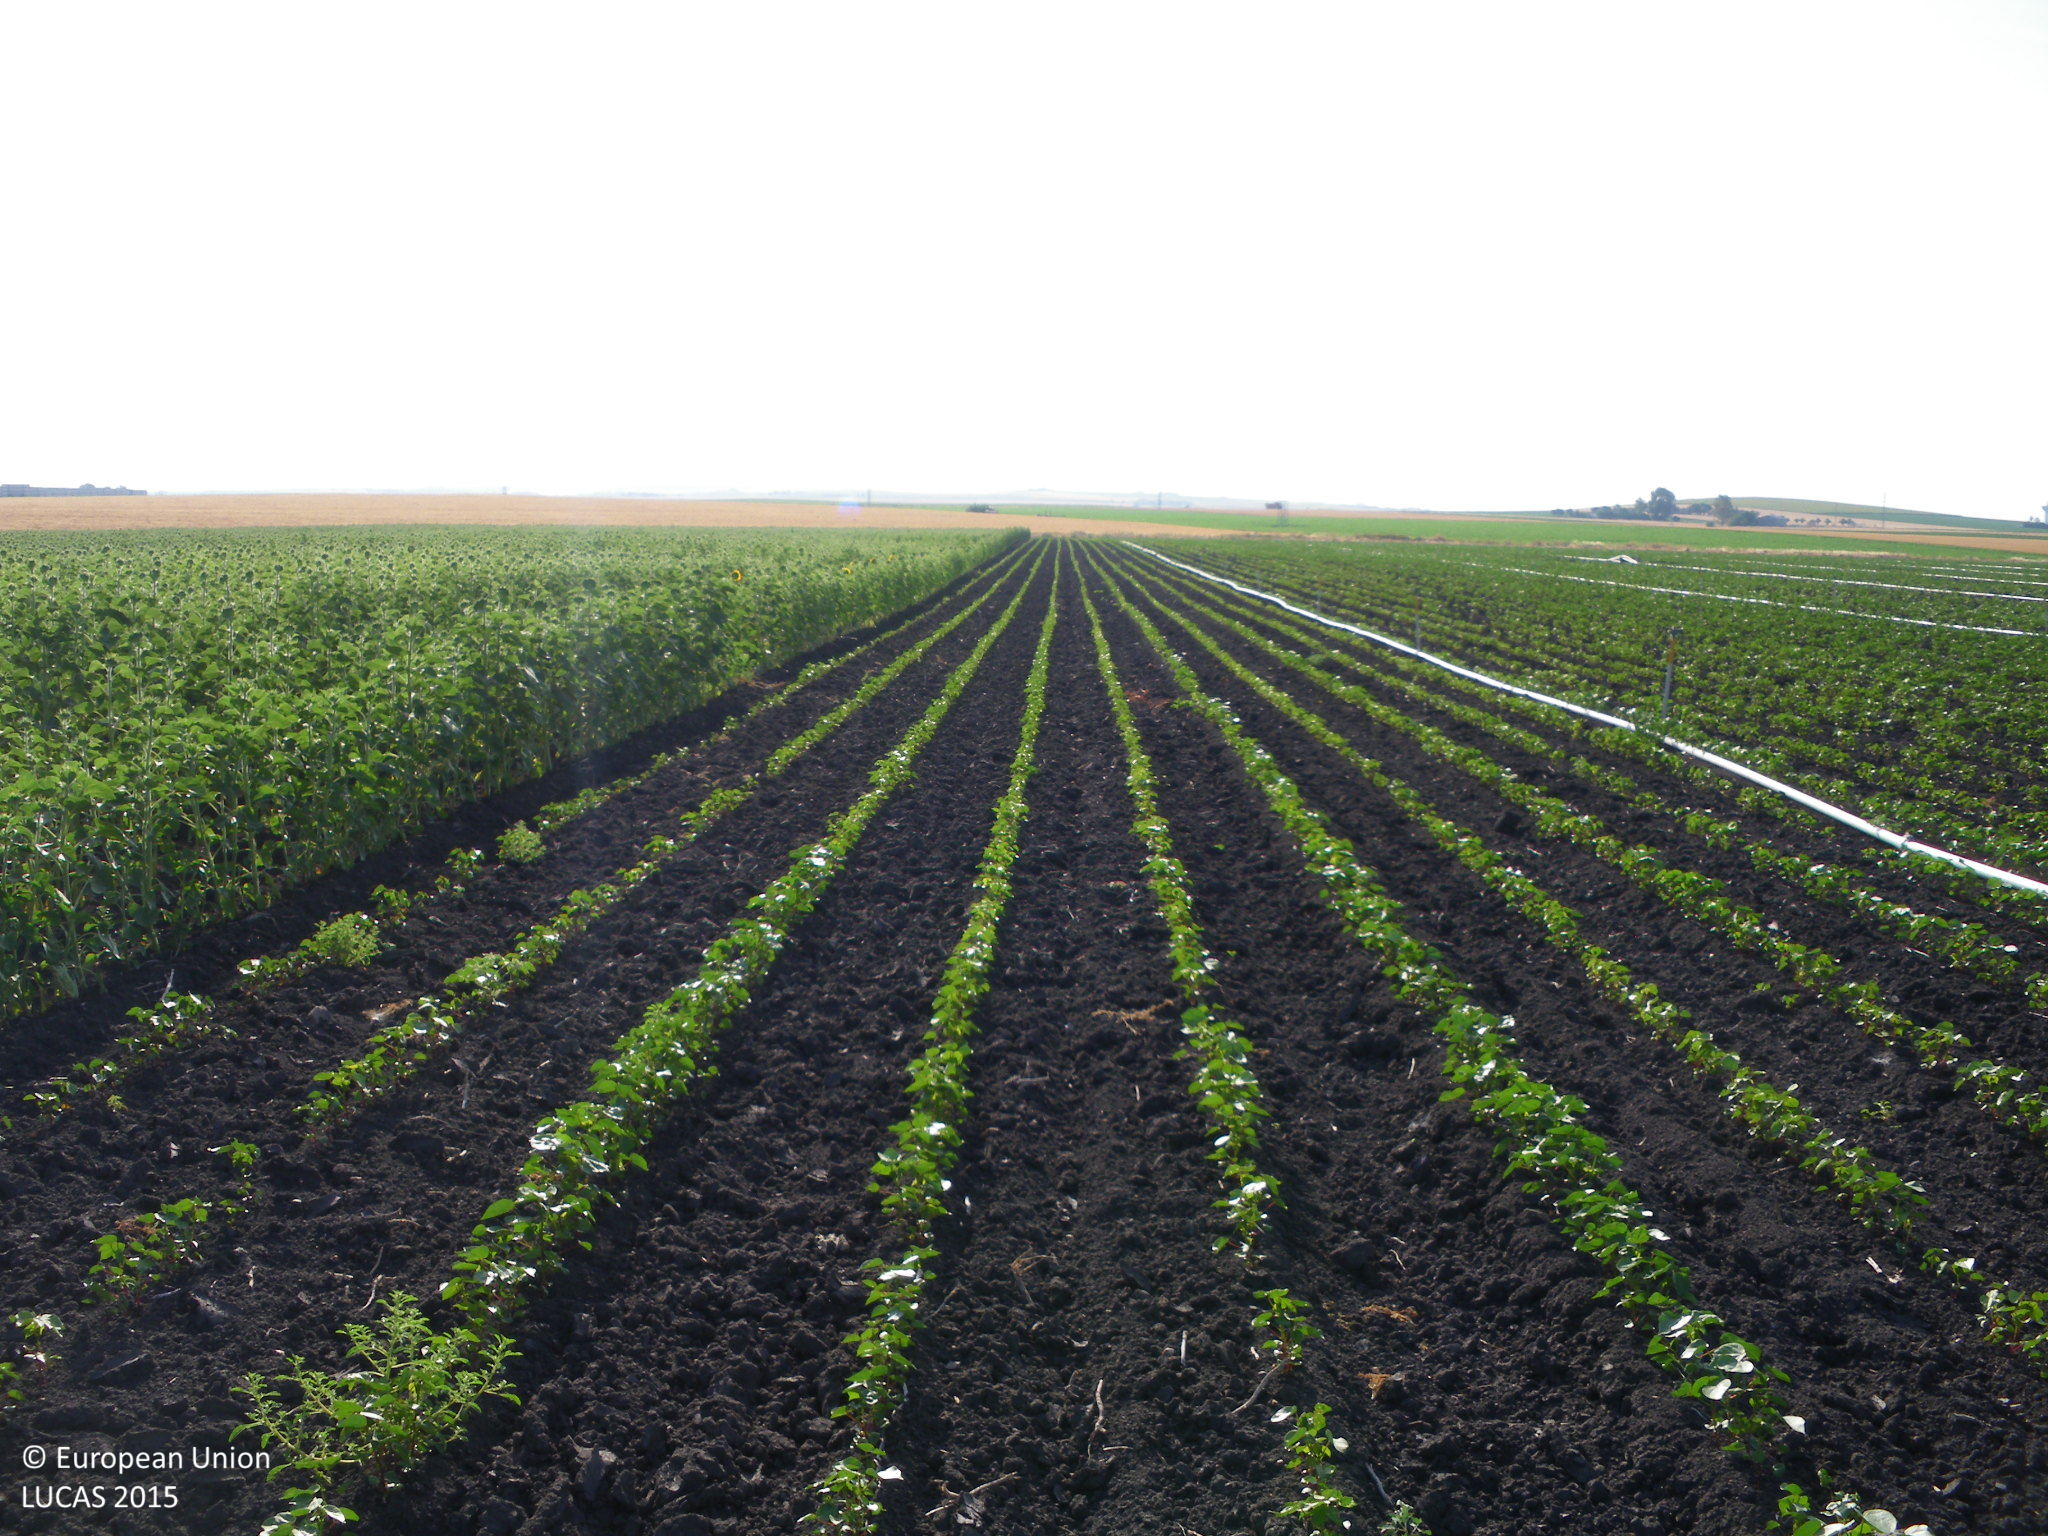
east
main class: Cropland
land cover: Cotton
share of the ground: 10 - 25 %
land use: Agriculture (excluding fallow land and kitchen gardens)
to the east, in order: Cotton; Sunflower
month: June
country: ES
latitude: 36.6821
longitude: -6.2971
